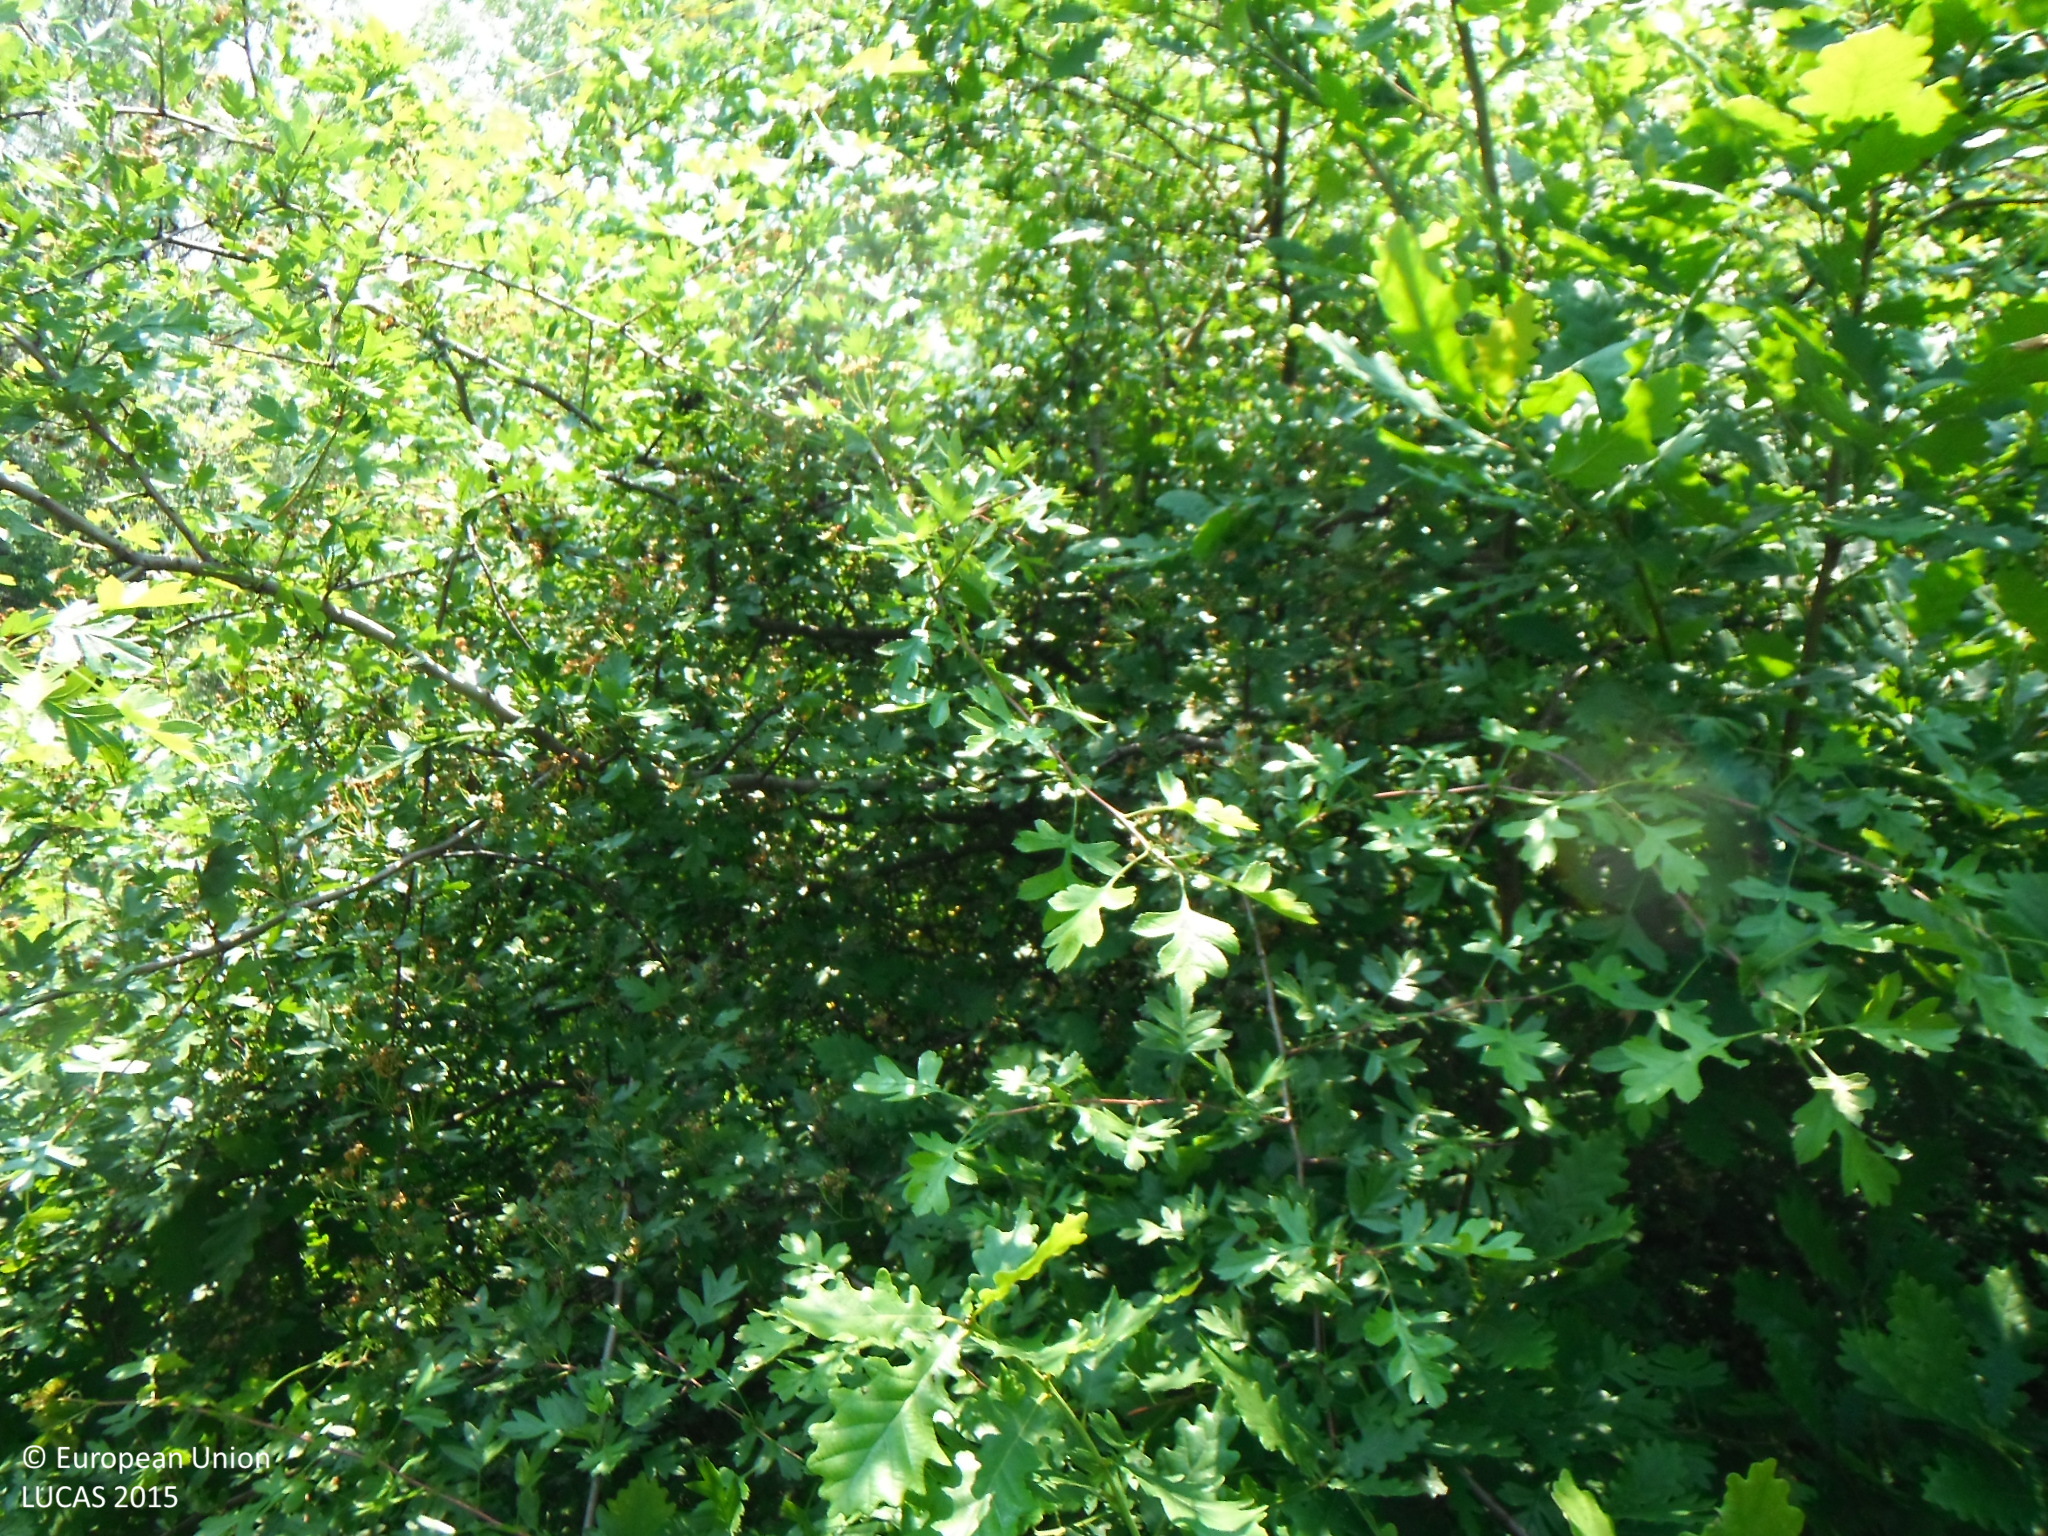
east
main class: Woodland
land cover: Broadleaved woodland
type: mesophytic deciduous forest
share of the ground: > 75 %
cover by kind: broadleaved forest trees 95 %, coniferous forest trees 5 %
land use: Forestry
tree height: > 5 m
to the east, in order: Broadleaved woodland; Tracks; Broadleaved woodland; Tracks; Spruce dominated mixed woodland
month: June
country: SK
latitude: 48.8485
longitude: 21.5642
